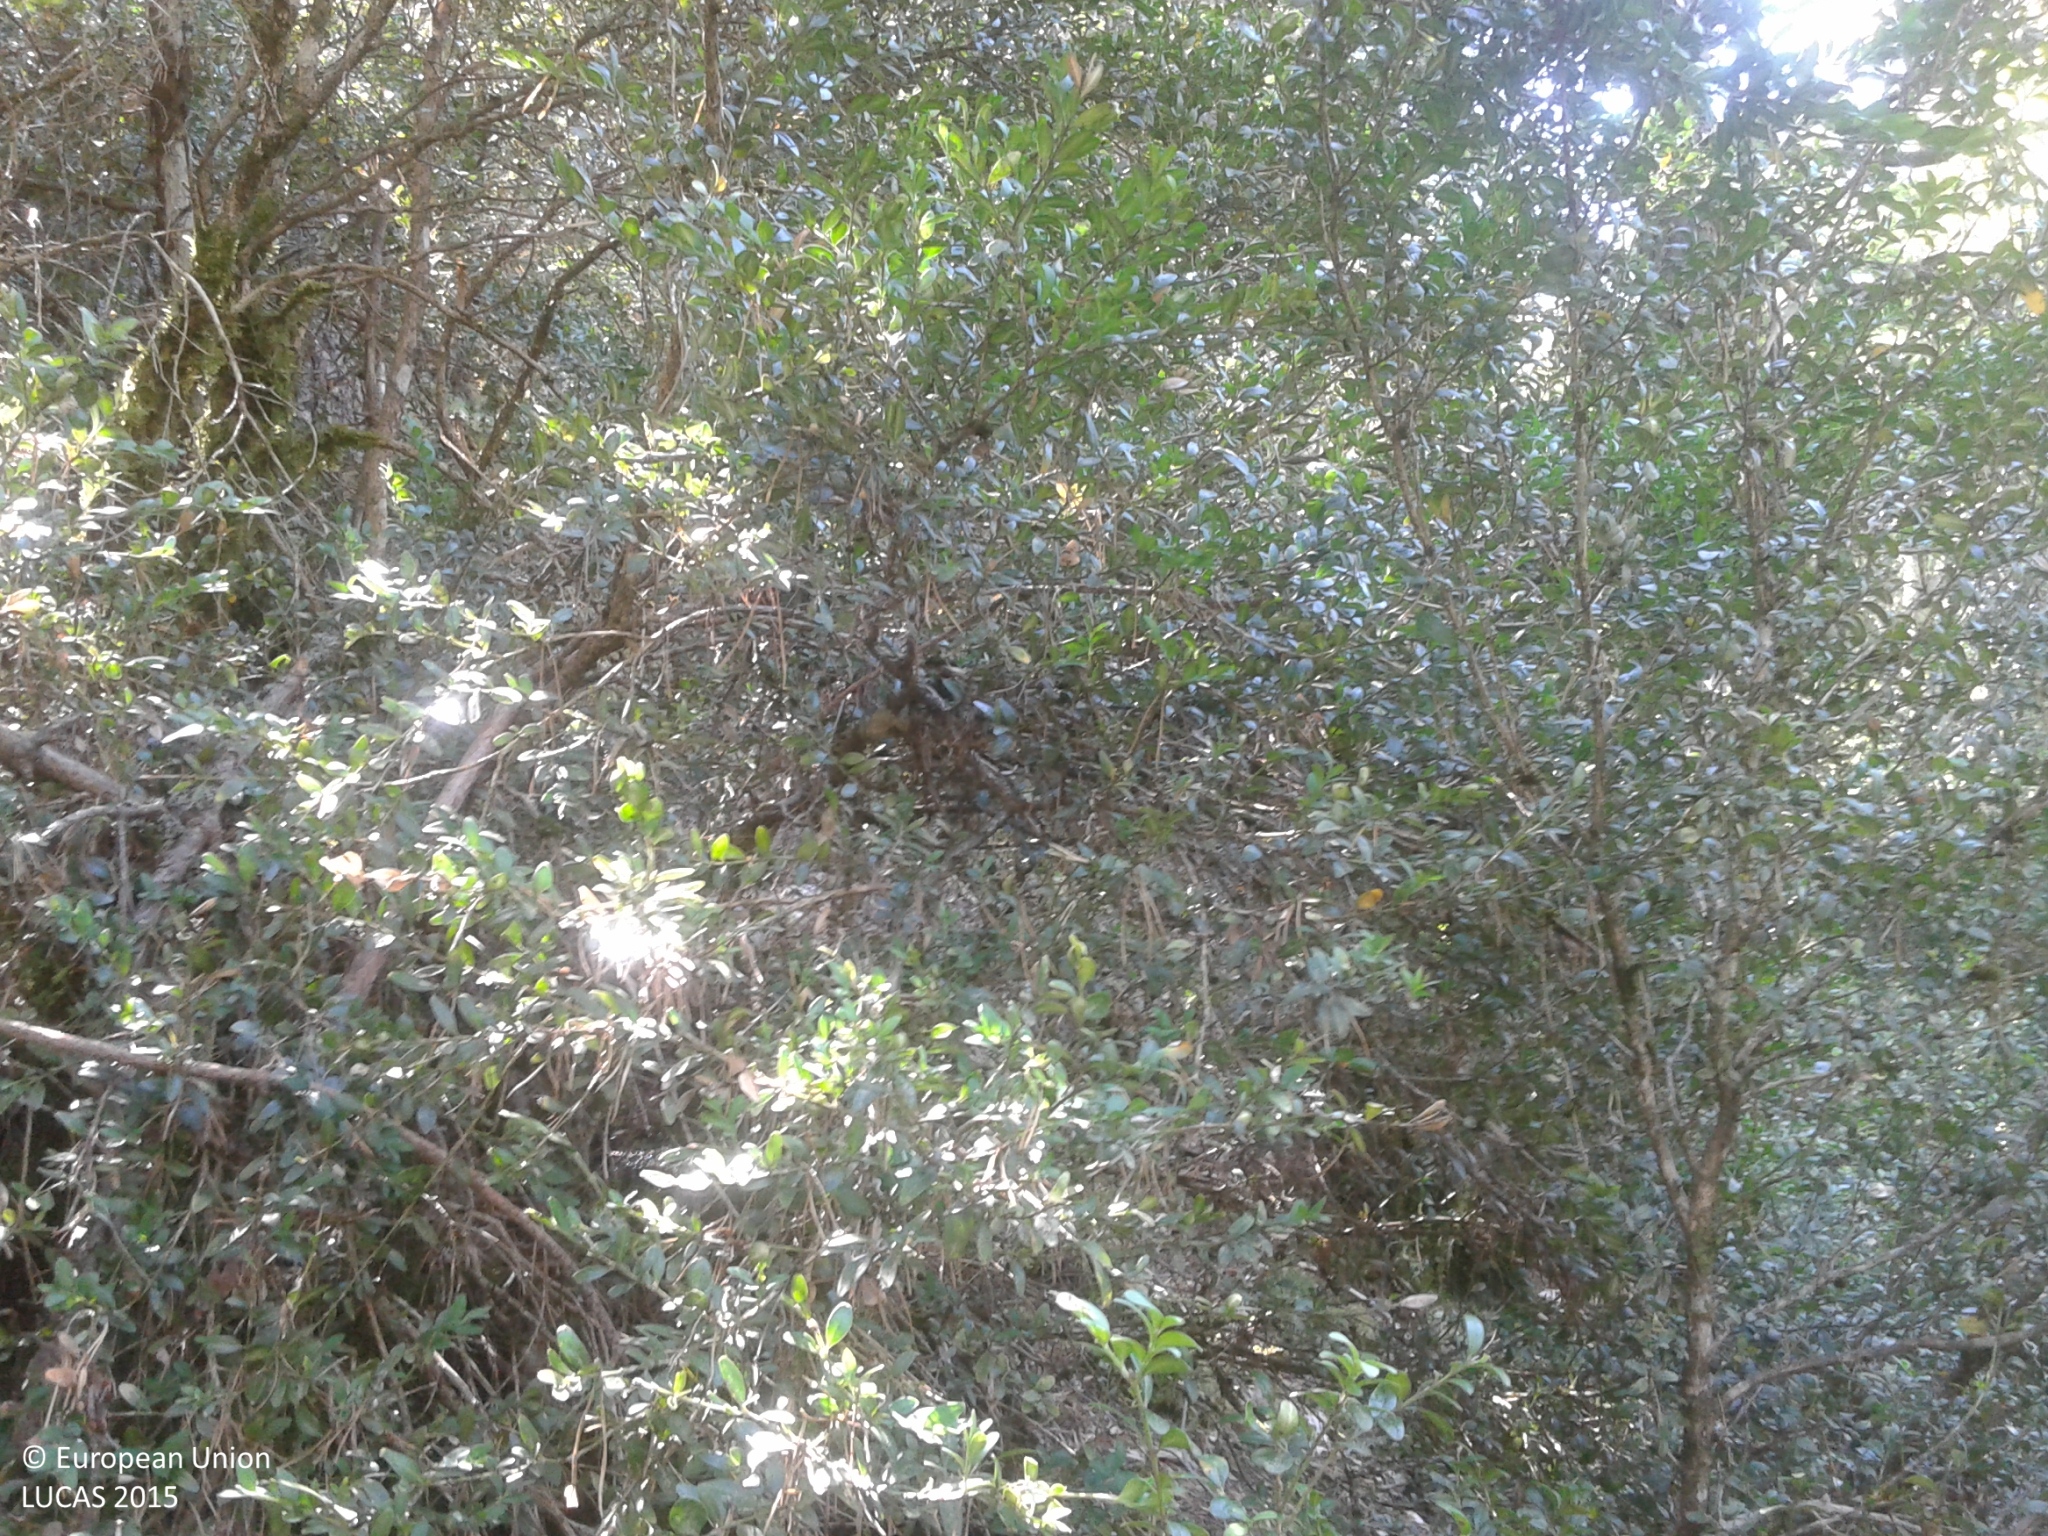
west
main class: Woodland
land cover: Pine dominated coniferous woodland
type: alpine coniferous forest
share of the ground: 50 - 75 %
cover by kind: coniferous forest trees 70 %, shrubs 30 %
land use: Semi-natural and natural areas not in use
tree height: > 5 m
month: July
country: ES
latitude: 42.3168
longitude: 1.5294
